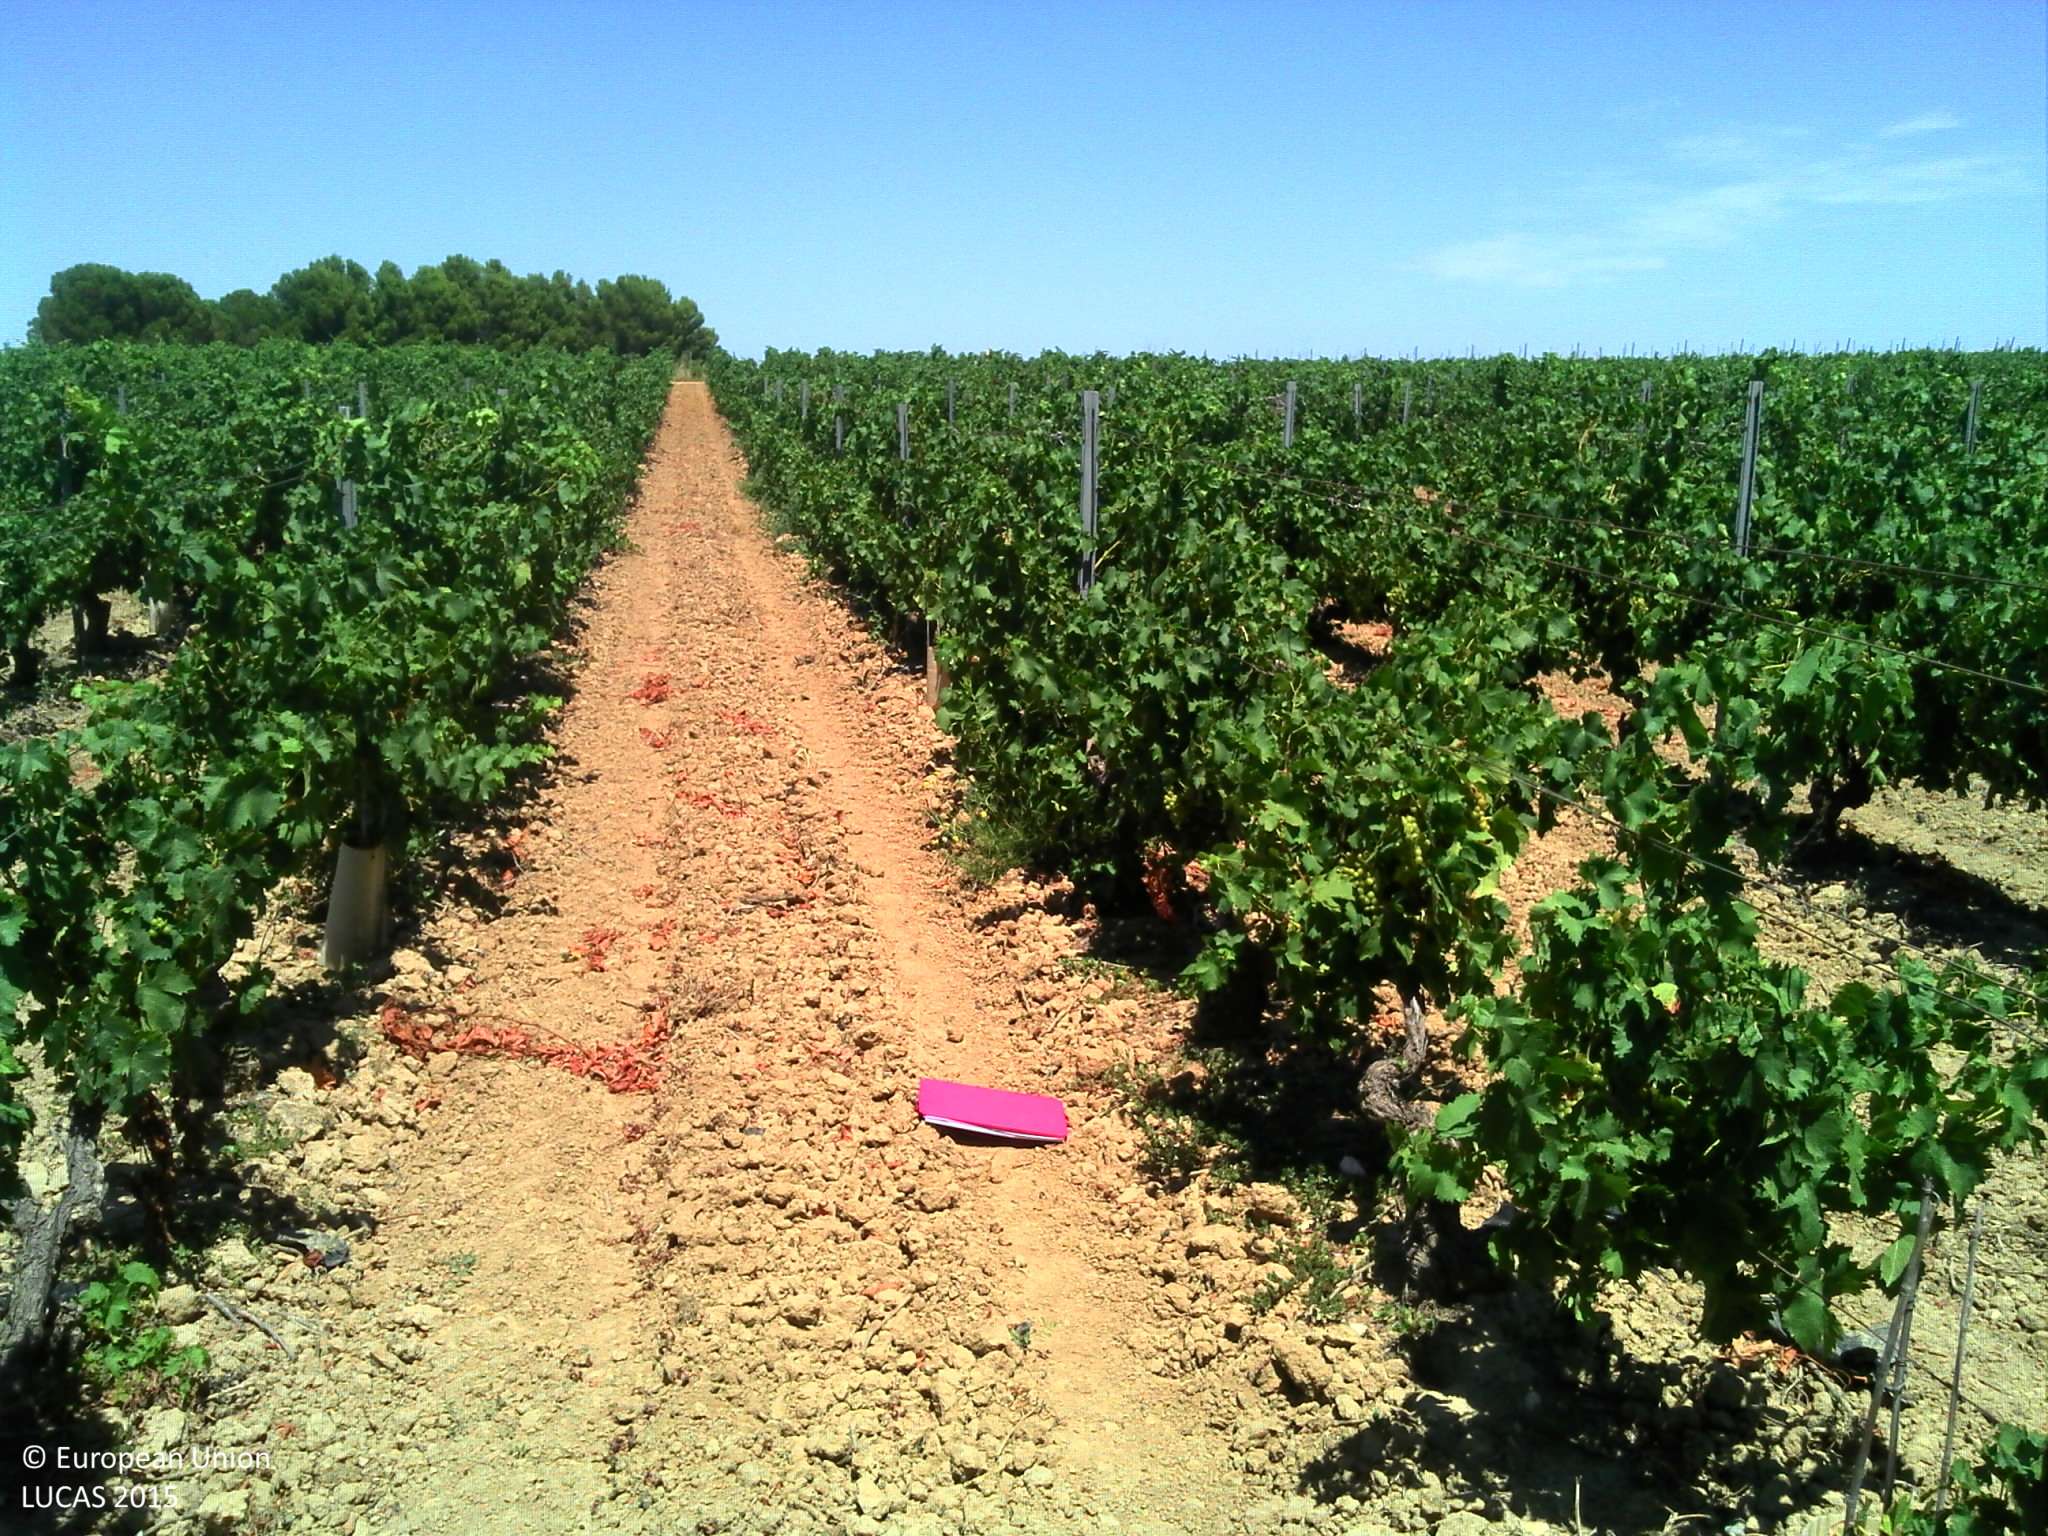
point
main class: Cropland
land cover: Vineyards
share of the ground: 50 - 75 %
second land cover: Other bare soil
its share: > 75 %
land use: Agriculture (excluding fallow land and kitchen gardens)
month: July
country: FR
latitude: 42.6224
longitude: 2.9042
